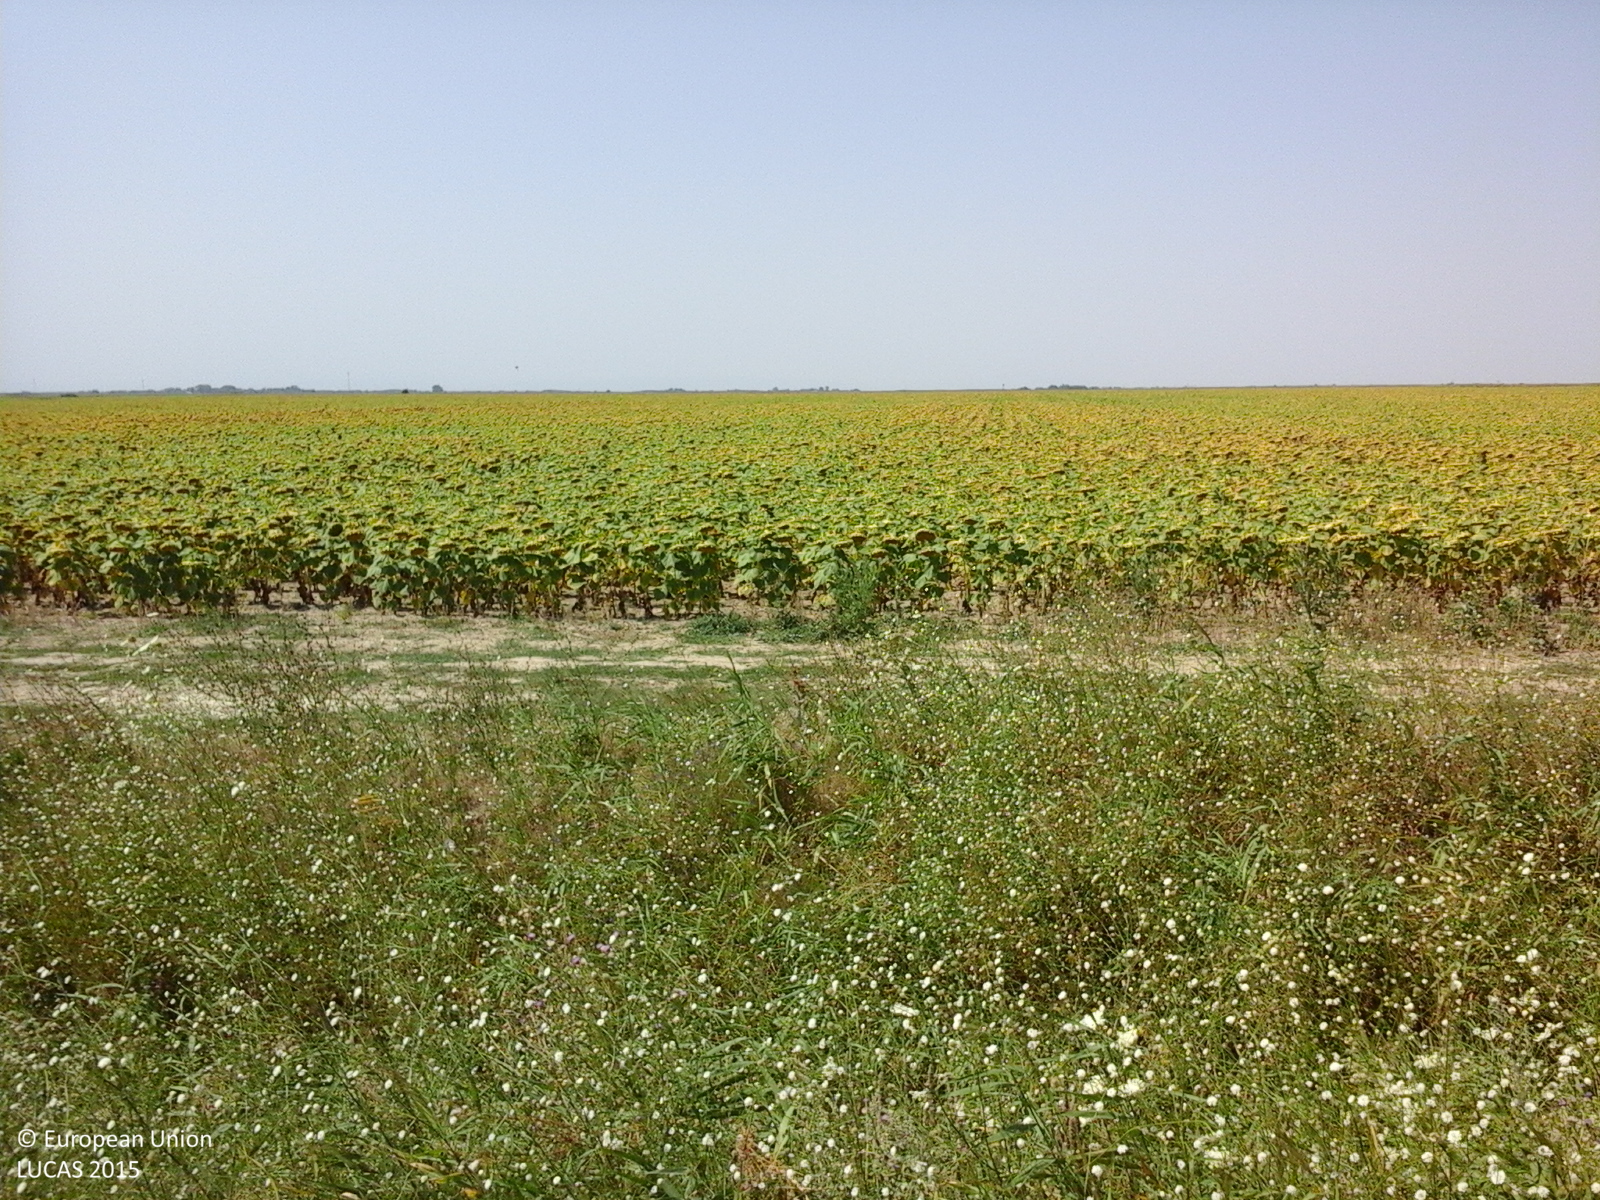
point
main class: Cropland
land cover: Sunflower
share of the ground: > 75 %
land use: Agriculture (excluding fallow land and kitchen gardens)
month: August
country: RO
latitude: 45.4940
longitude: 27.5450
